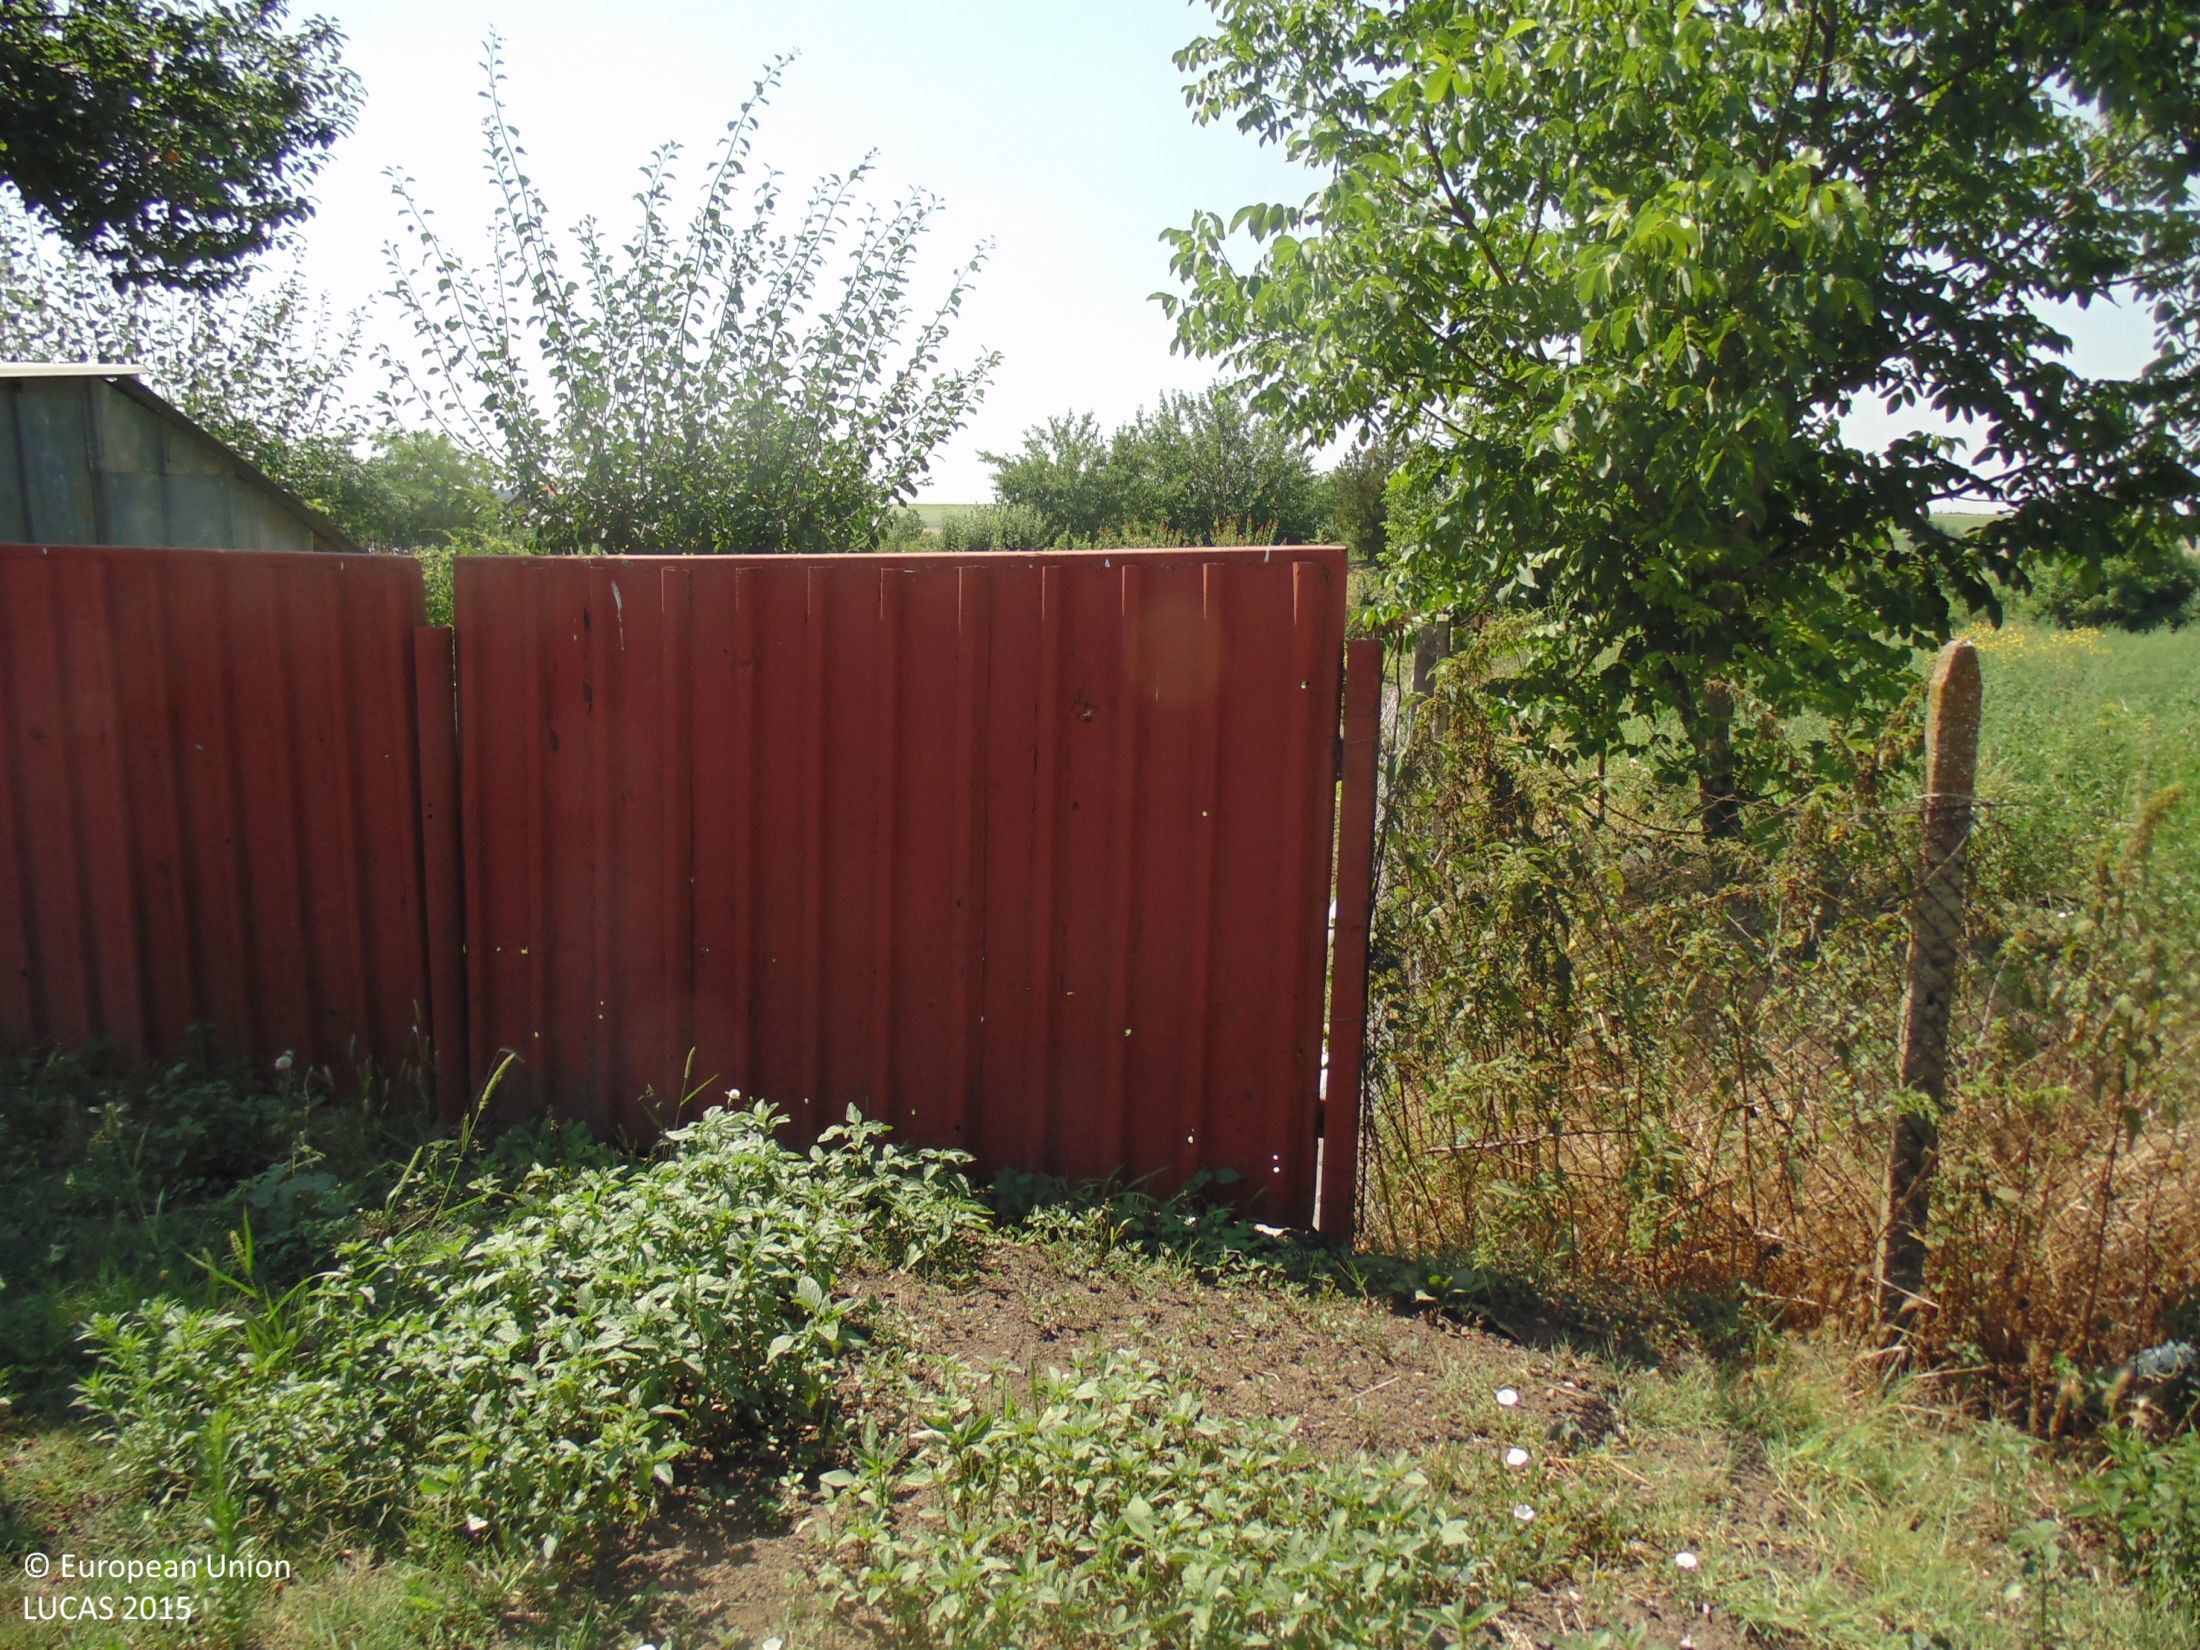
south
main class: Grassland
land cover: Grassland with sparse tree/shrub cover
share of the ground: 50 - 75 %
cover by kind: herbaceous plants 65 %, unconsolidated bare surface 25 %, broadleaved forest trees 5 %, shrubs 5 %
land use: Residential
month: July
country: BG
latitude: 43.6511
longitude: 27.6564
